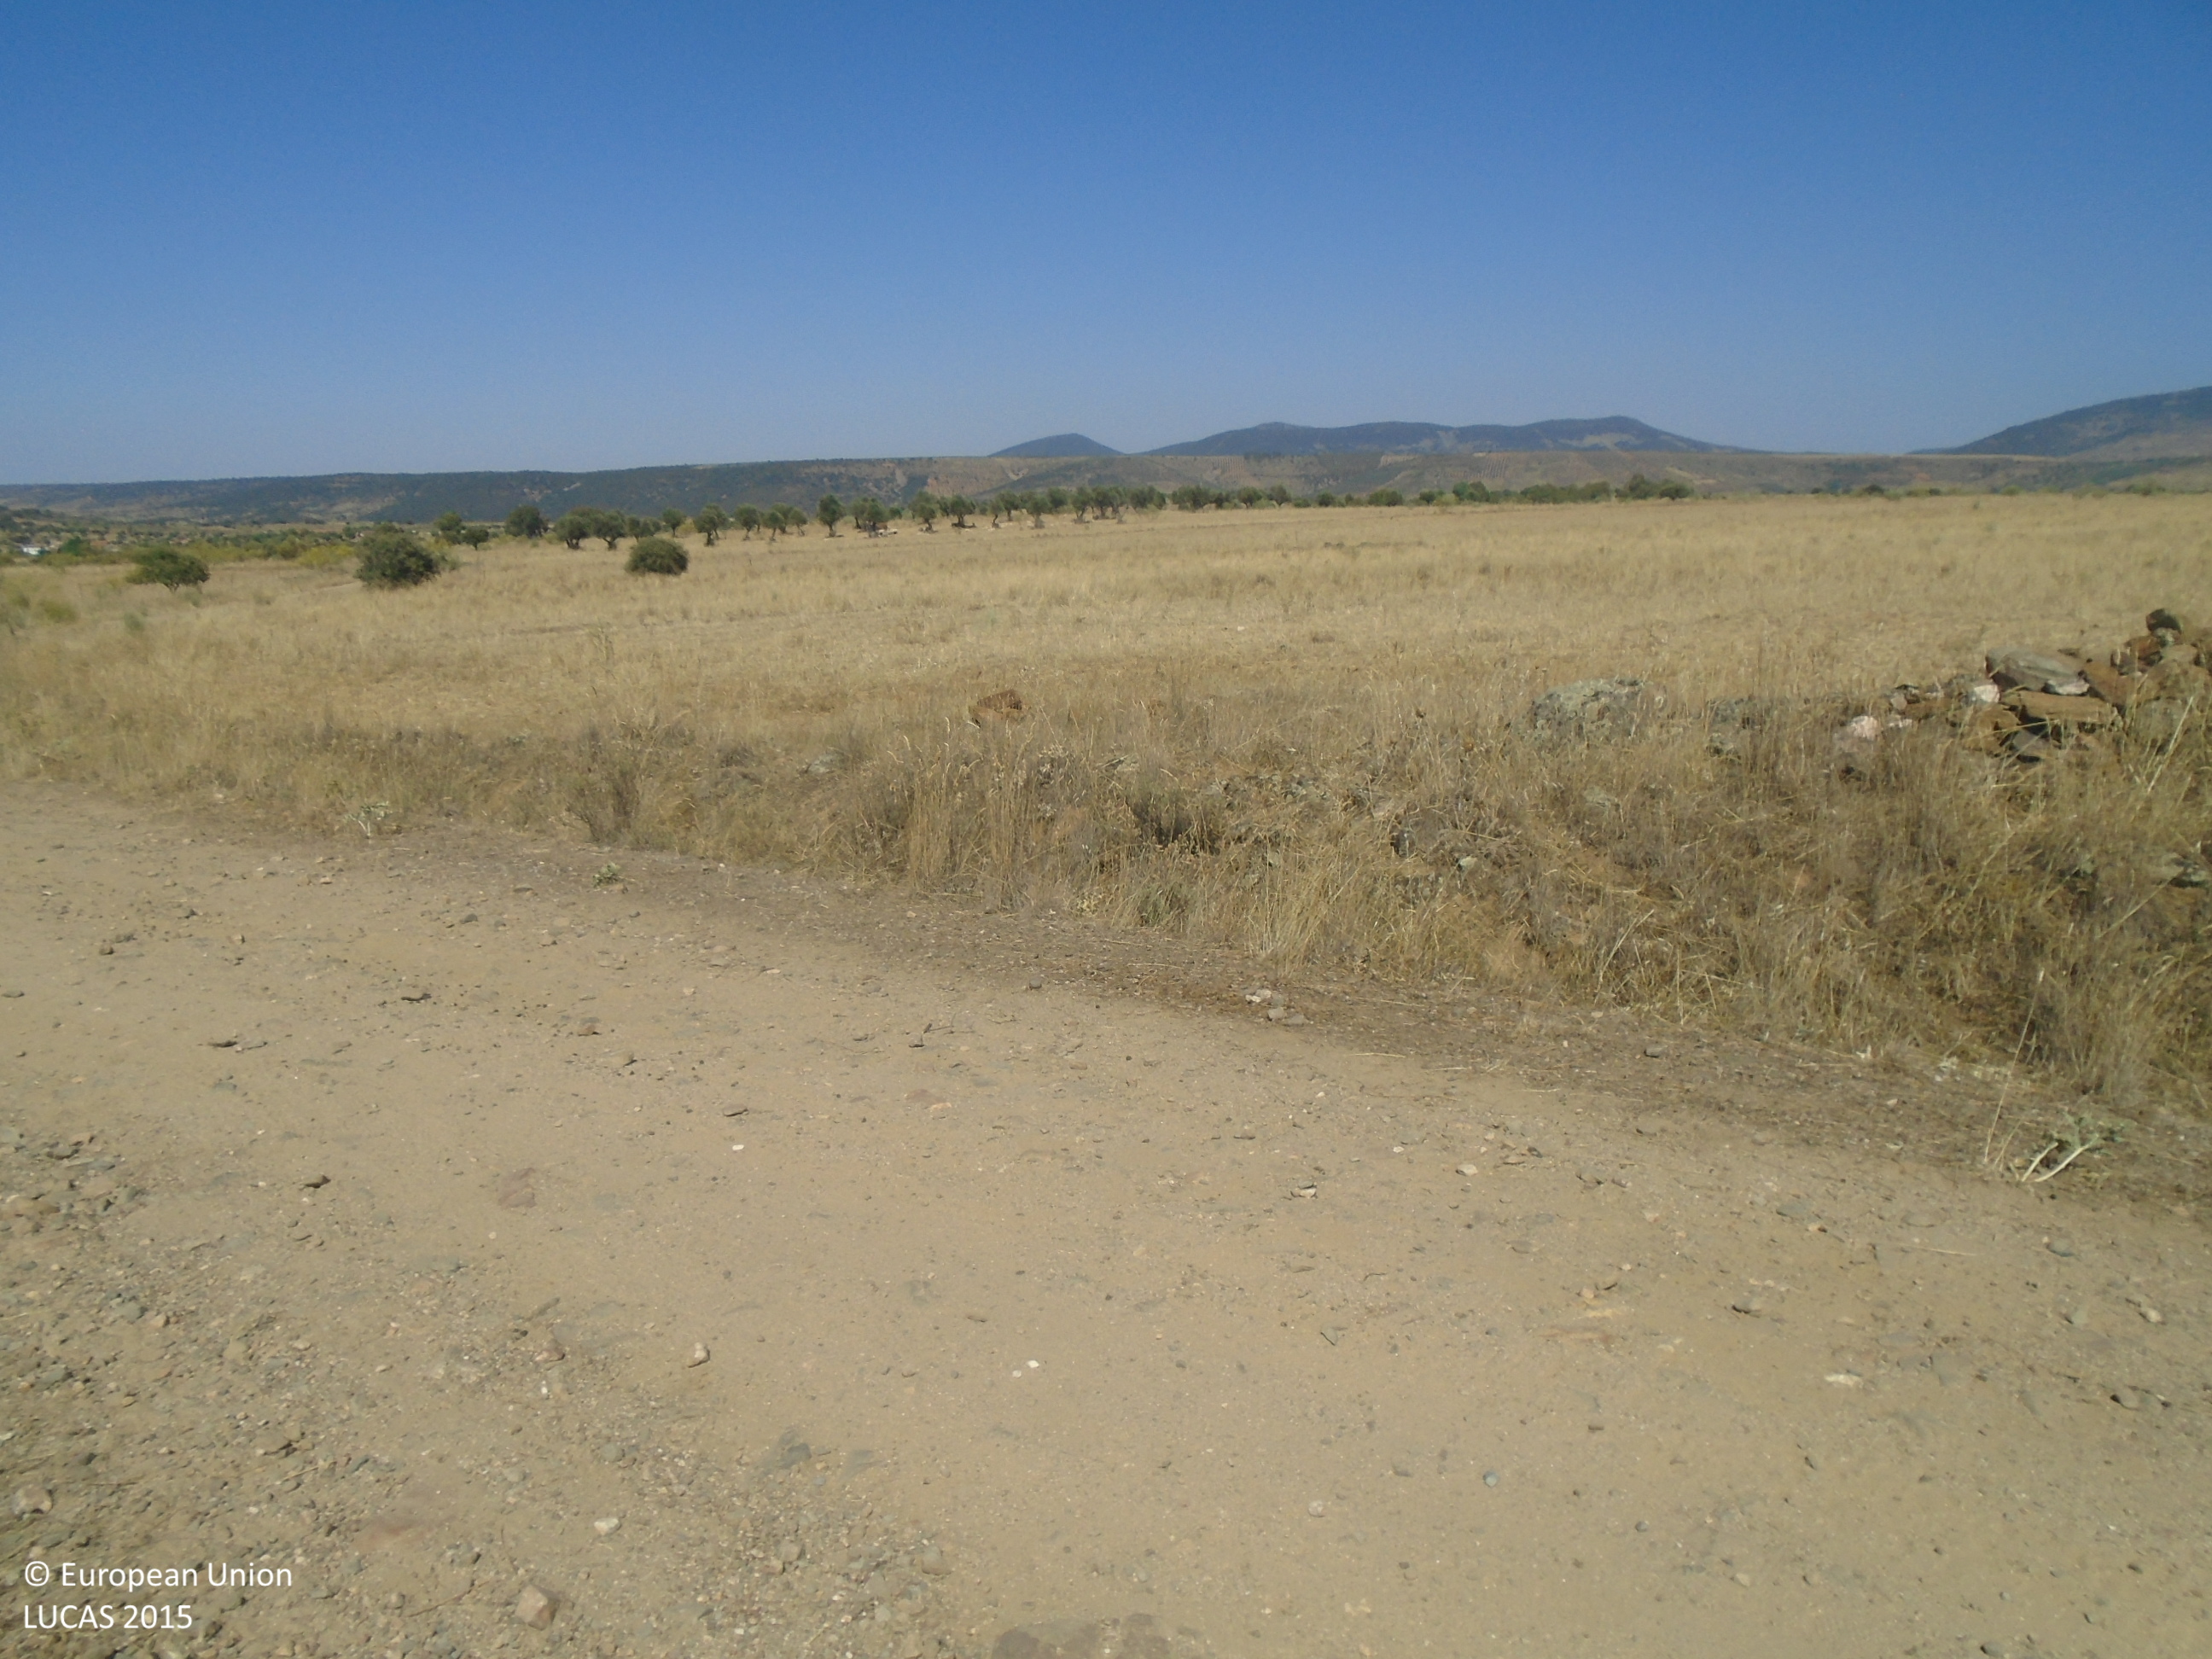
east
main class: Grassland
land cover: Spontaneously vegetated surfaces
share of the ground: > 75 %
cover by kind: herbaceous plants 100 %
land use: Abandoned areas
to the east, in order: Spontaneously vegetated surfaces; Fences; Grass margins; Ditches and canals; Grass margins; Tracks; Grass margins; Ditches and canals; Spontaneously vegetated surfaces; Barley; Grass margins; Fences; Spontaneously vegetated surfaces; Fences; Spontaneously vegetated surfaces
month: July
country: ES
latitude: 39.6649
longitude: -5.0725
